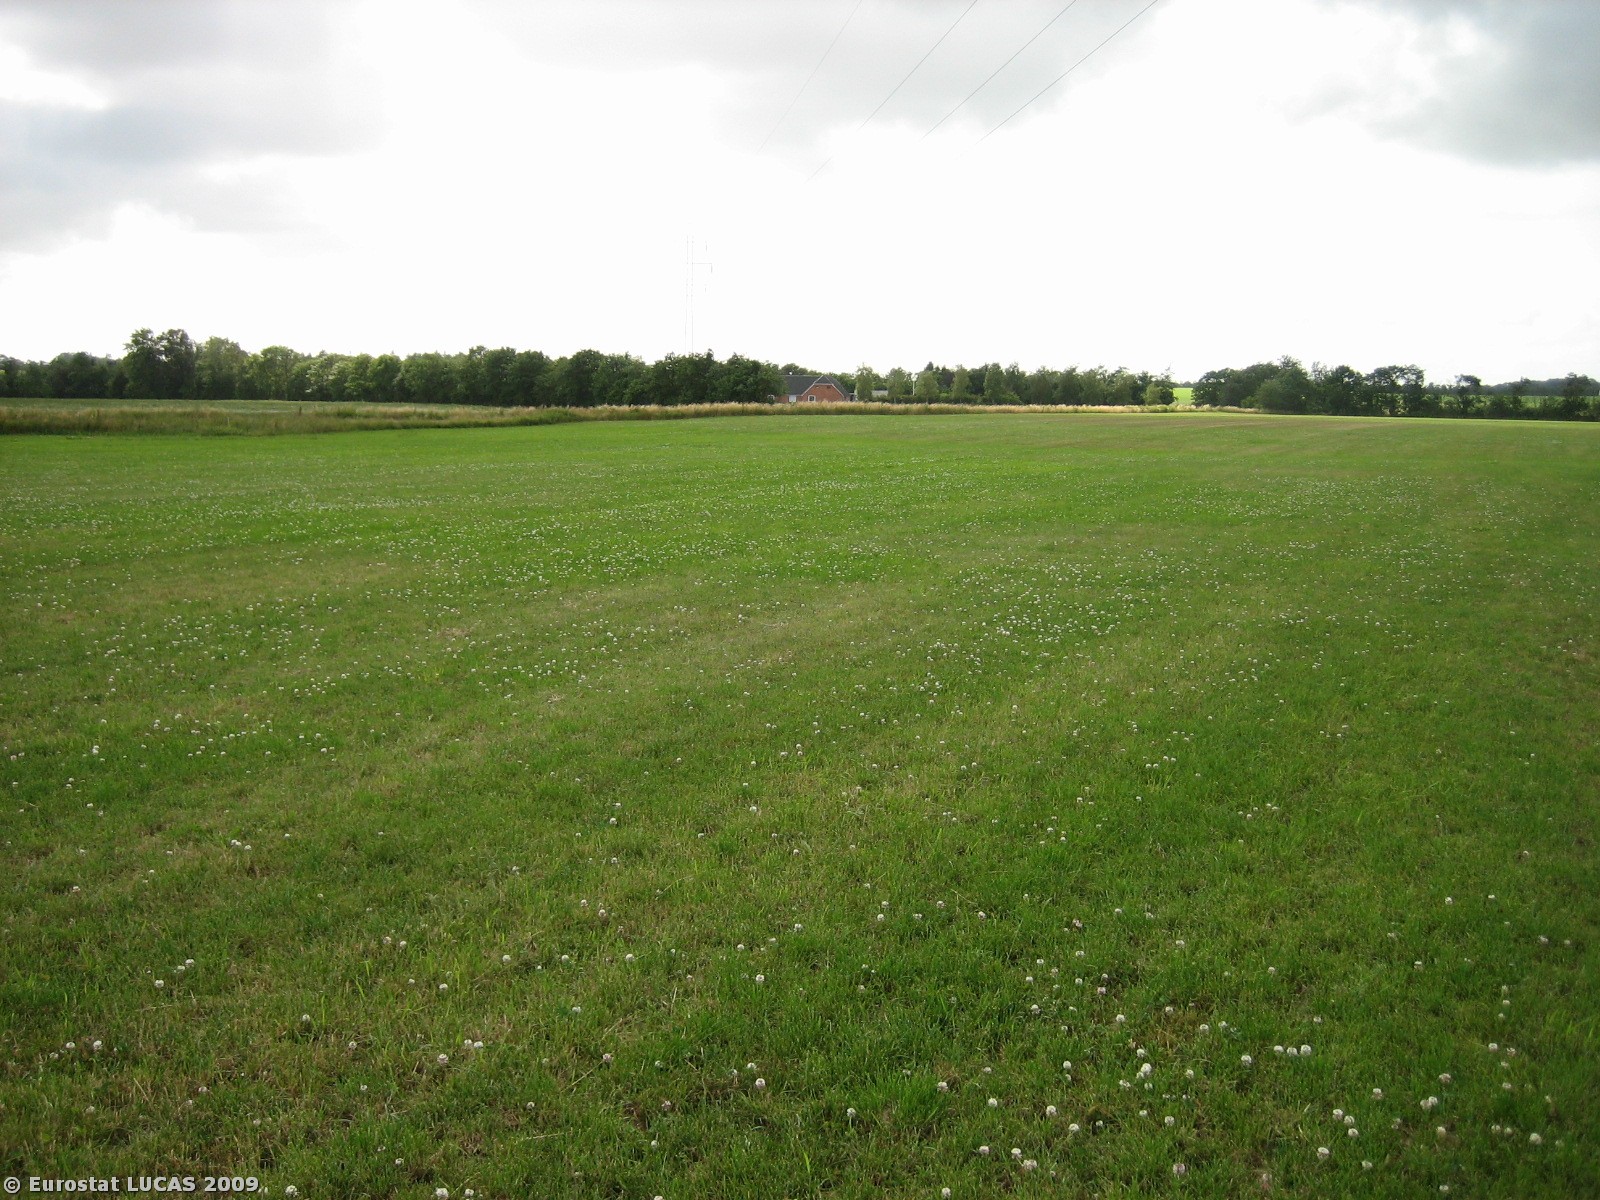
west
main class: Cropland
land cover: Temporary grasslands
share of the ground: > 75 %
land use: Agriculture (excluding fallow land and kitchen gardens)
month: July
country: DK
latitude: 55.7298
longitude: 8.5205
